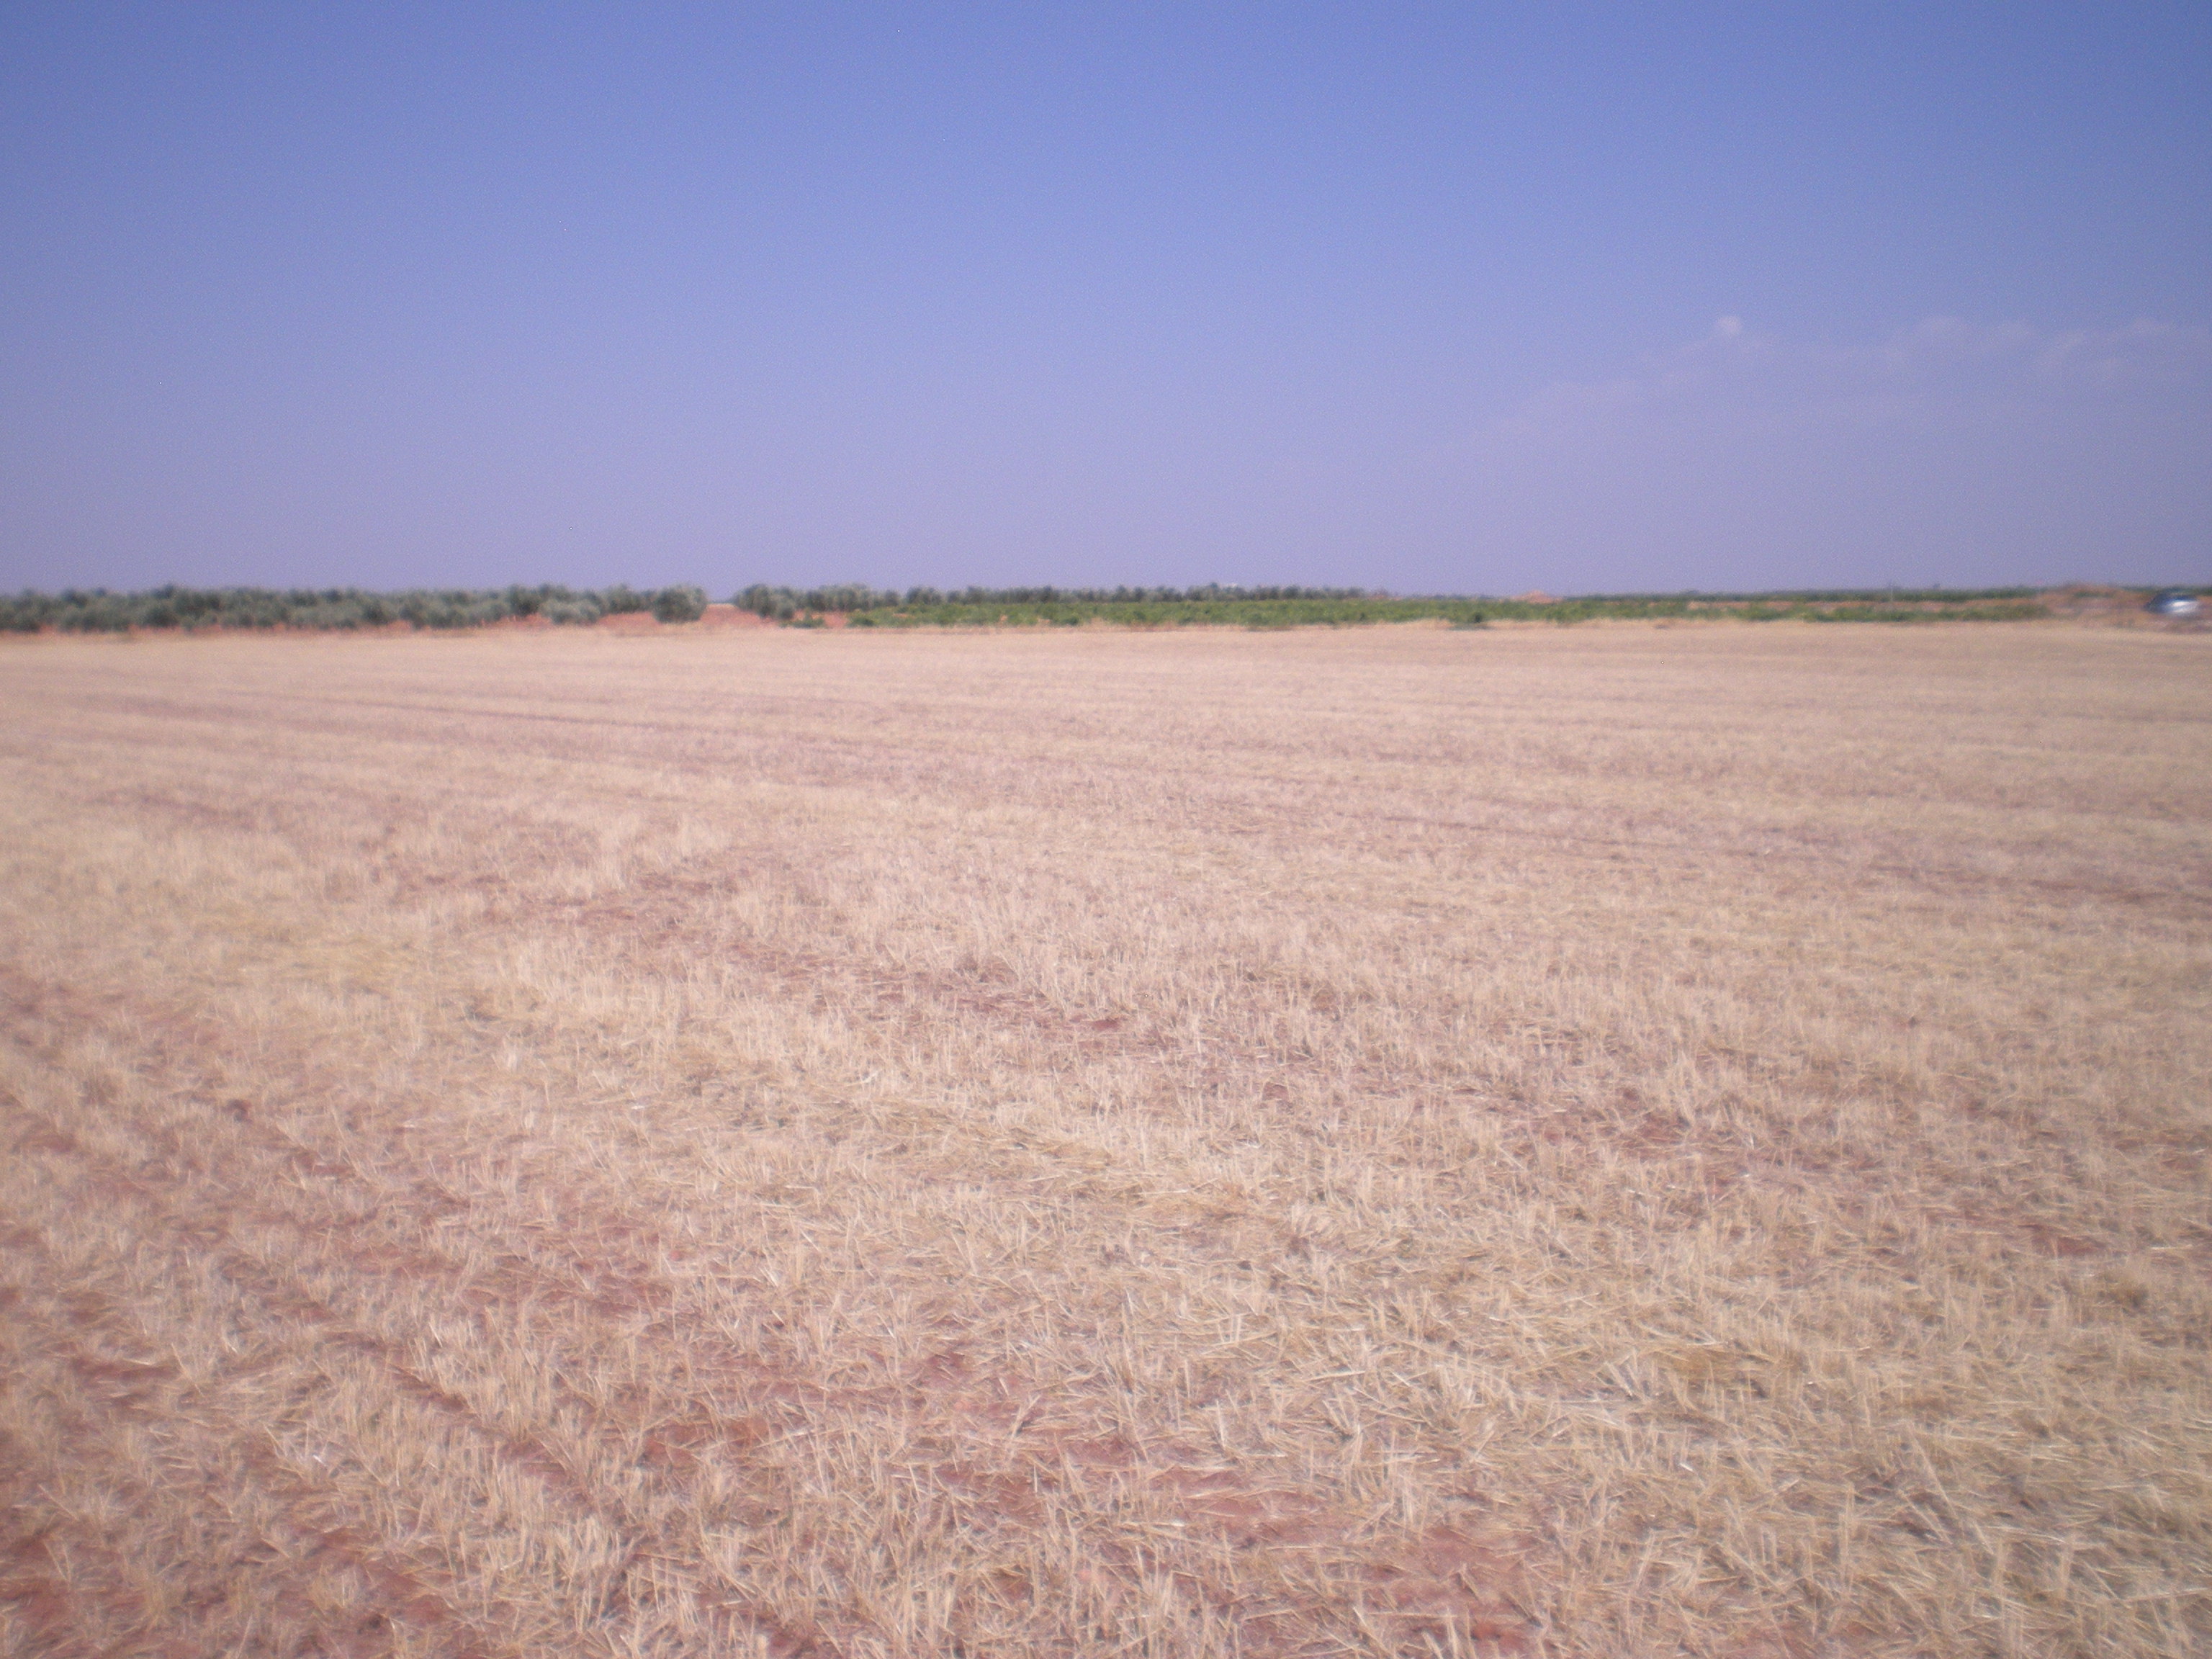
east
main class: Cropland
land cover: Barley
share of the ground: < 10 %
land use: Agriculture (excluding fallow land and kitchen gardens)
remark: Harvested field
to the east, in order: Barley; Grass margins; Tracks; Grass margins; Vineyards; Olive groves
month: July
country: ES
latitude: 39.3785
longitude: -3.1465
